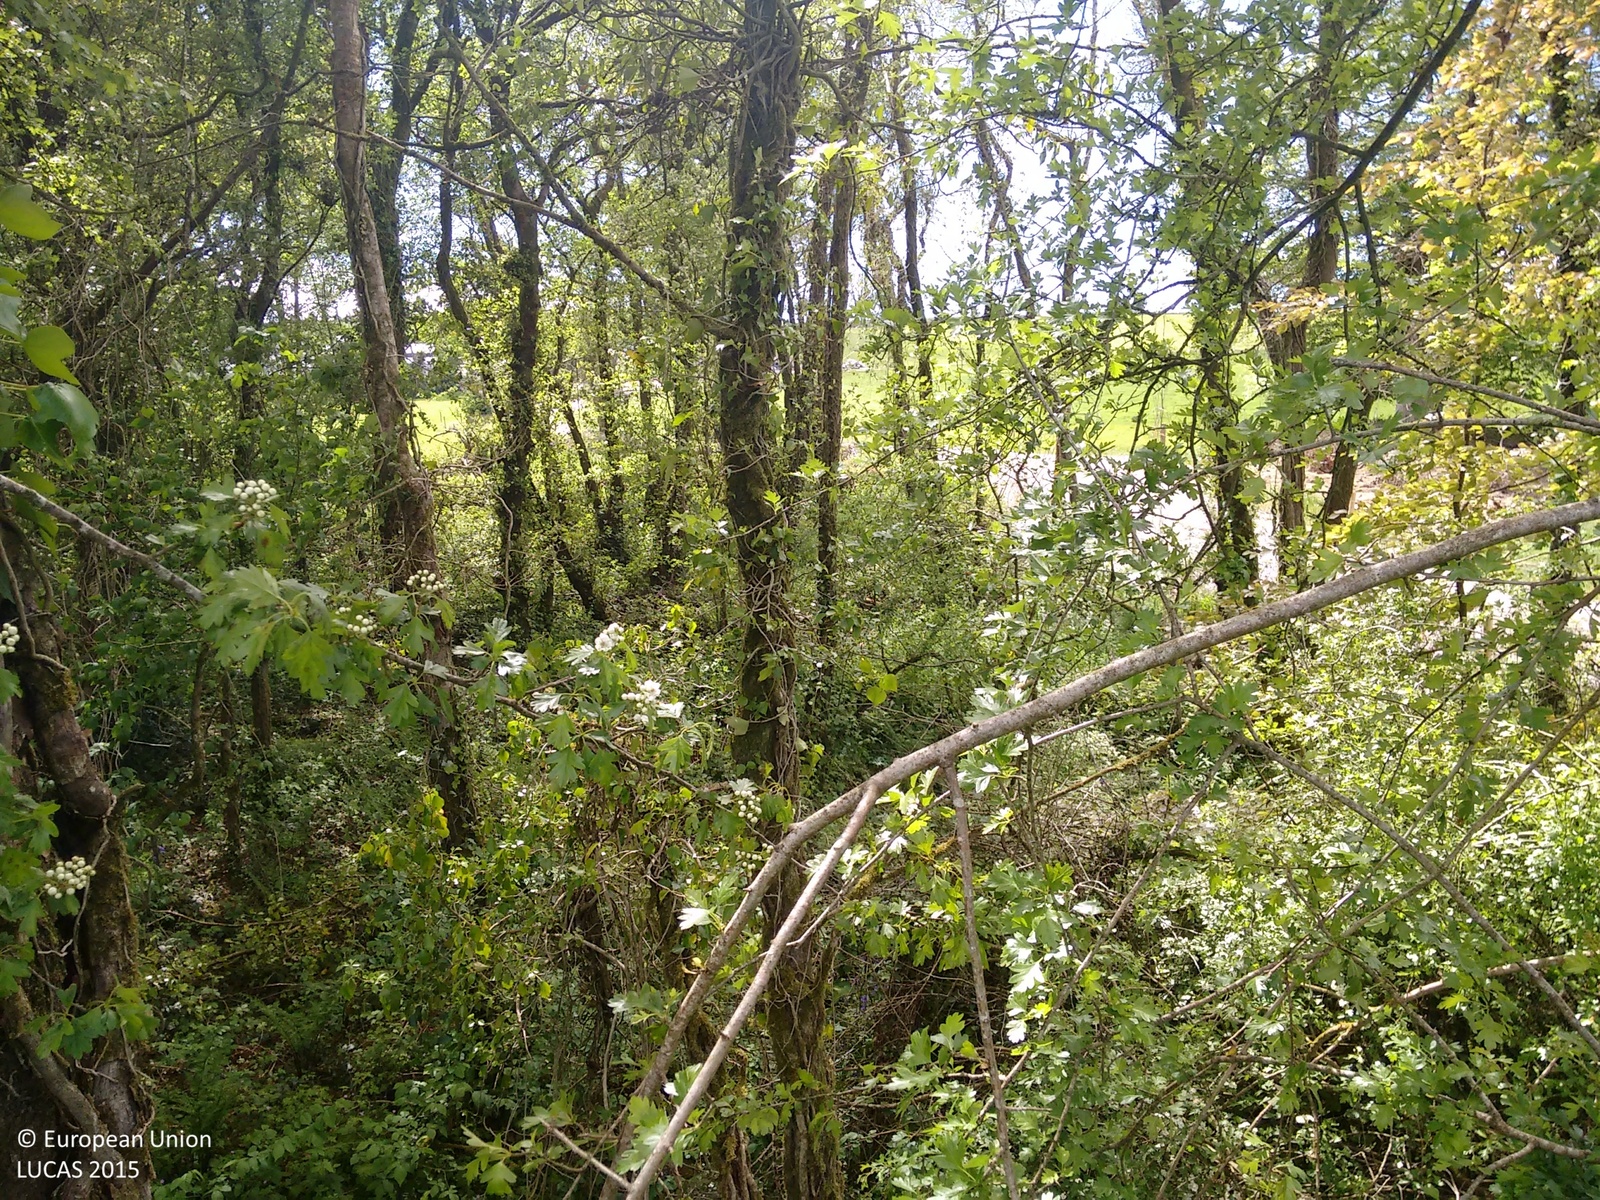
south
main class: Woodland
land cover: Broadleaved woodland
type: mesophytic deciduous forest
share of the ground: > 75 %
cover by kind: broadleaved forest trees 50 %, herbaceous plants 50 %
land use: Semi-natural and natural areas not in use
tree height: > 5 m
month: May
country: IE
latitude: 51.8448
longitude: -8.7393
